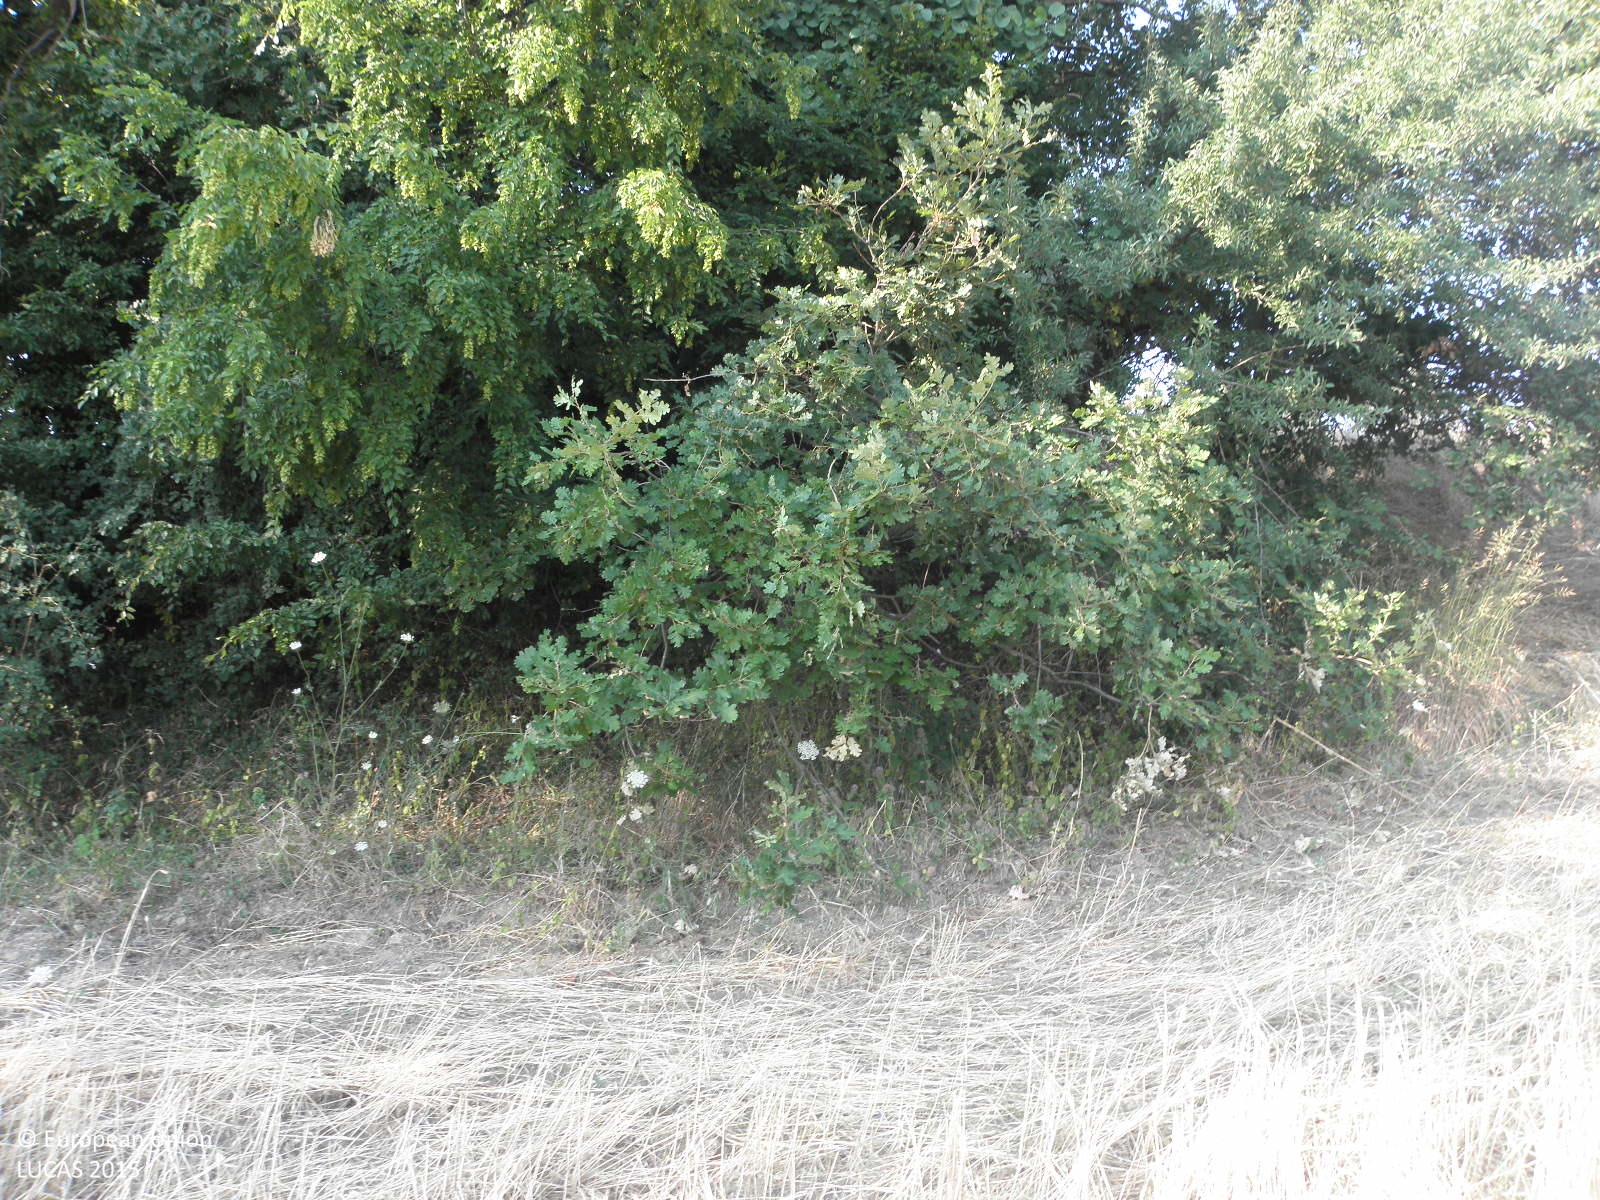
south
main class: Cropland
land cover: Common wheat
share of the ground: > 75 %
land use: Agriculture (excluding fallow land and kitchen gardens)
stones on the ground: 10 - 25 %
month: July
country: GR
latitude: 40.3642
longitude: 22.4697
